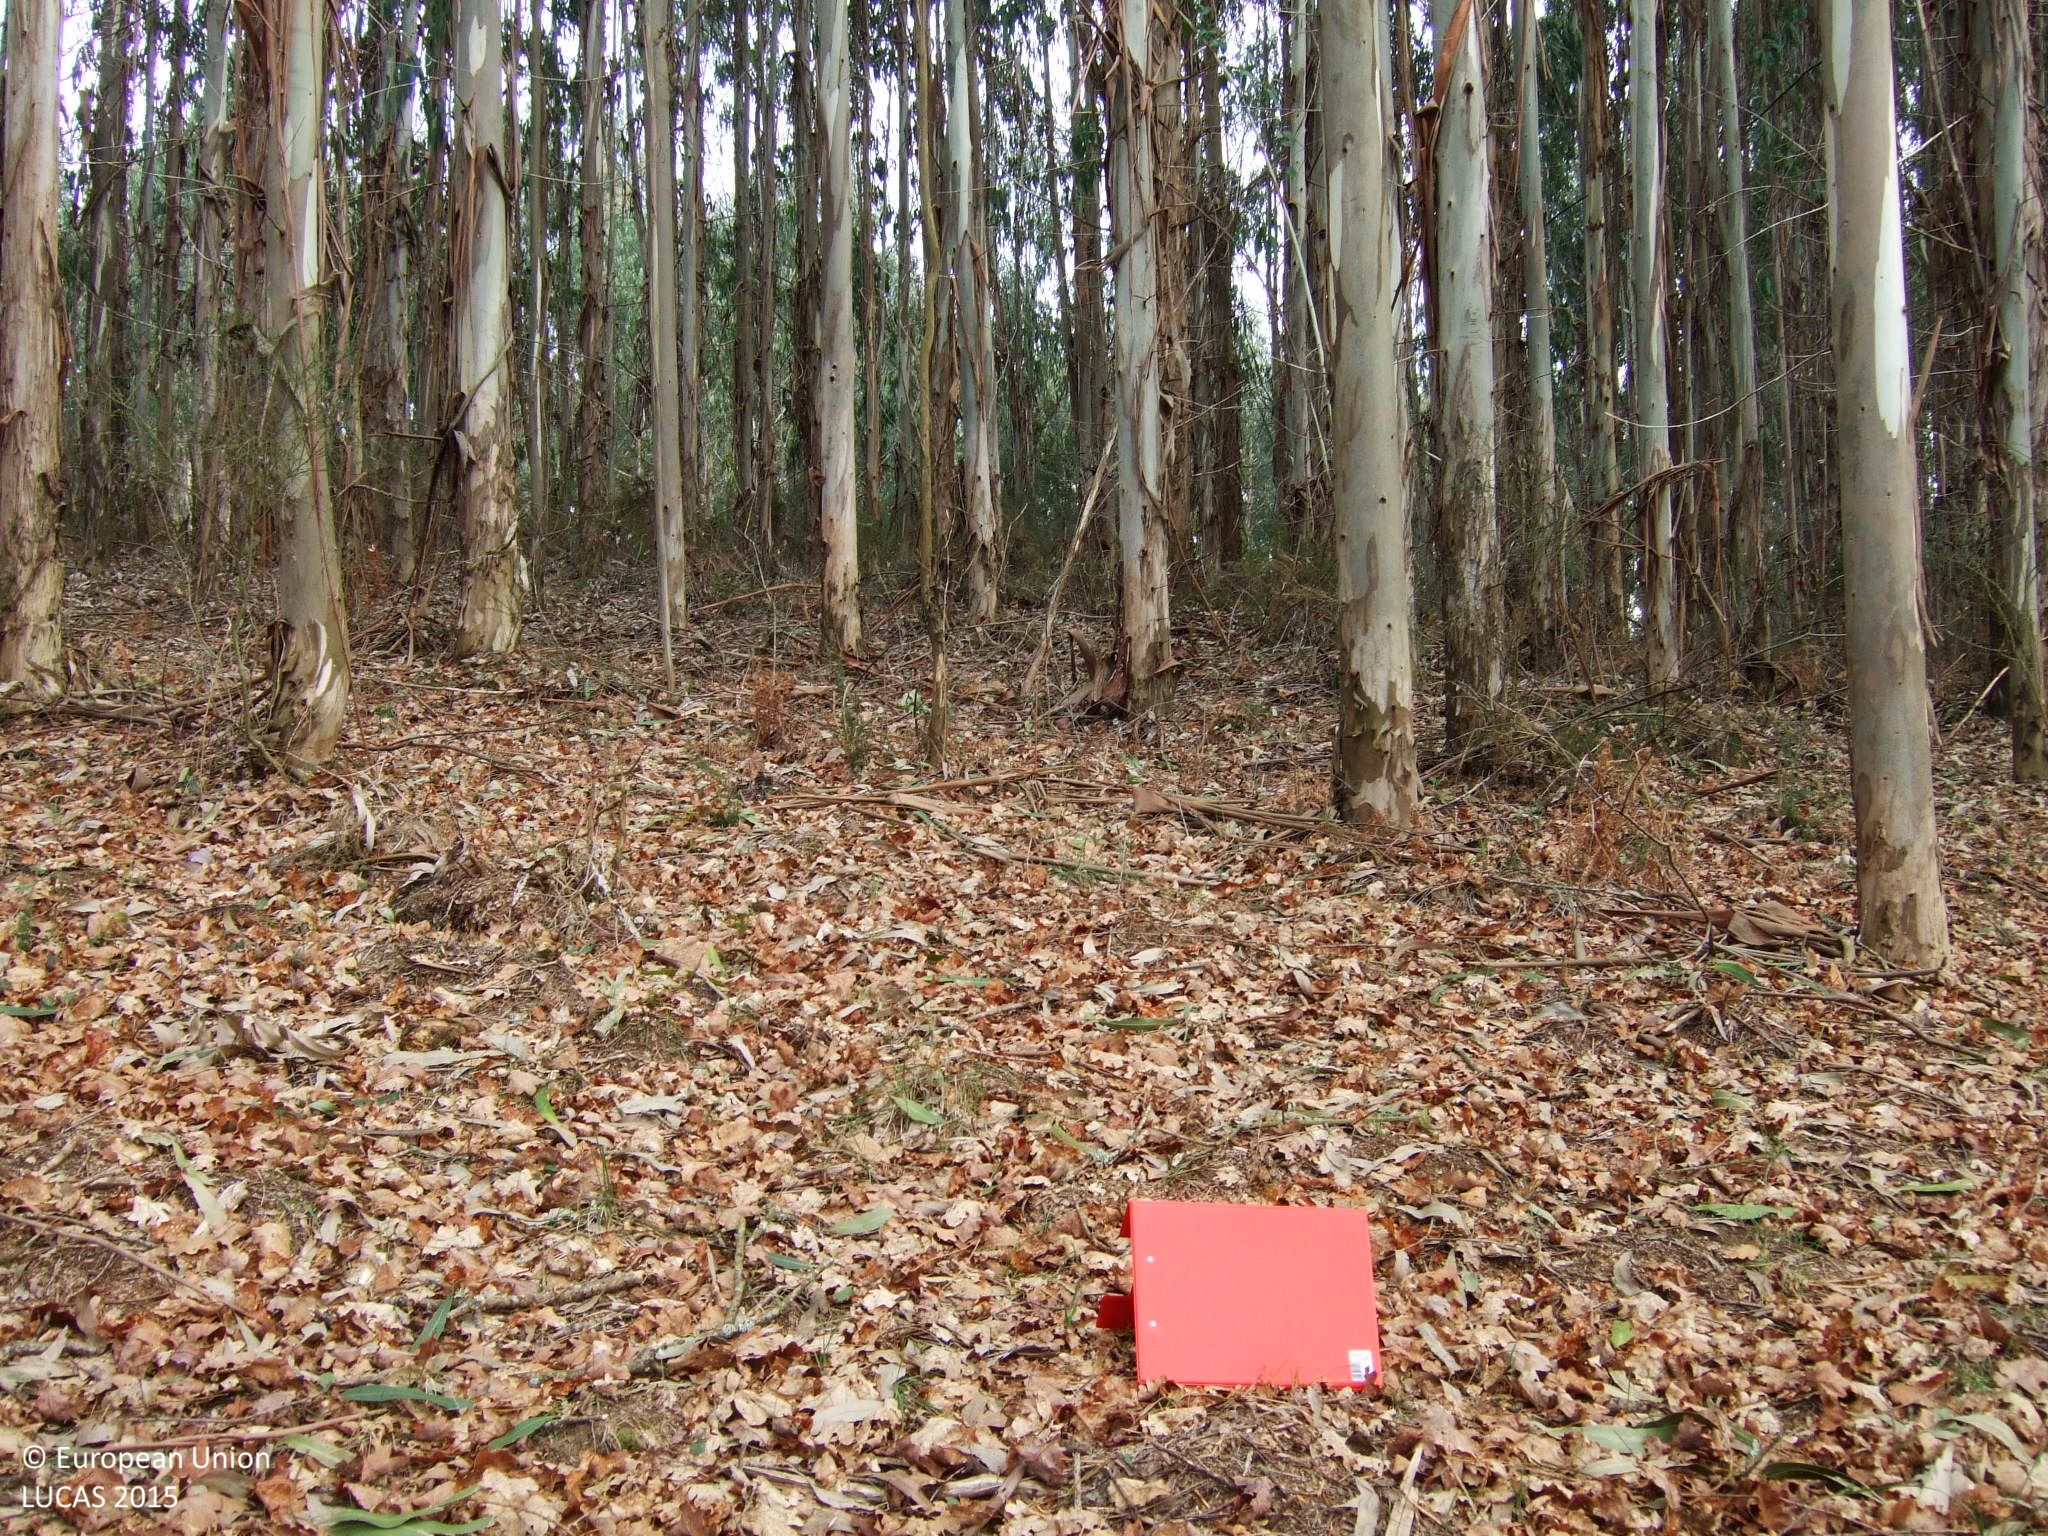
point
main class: Woodland
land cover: Broadleaved woodland
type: exotic forest
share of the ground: > 75 %
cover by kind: broadleaved forest trees 80 %, shrubs 20 %
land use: Forestry
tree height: > 5 m
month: March
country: ES
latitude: 42.8321
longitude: -7.9092
